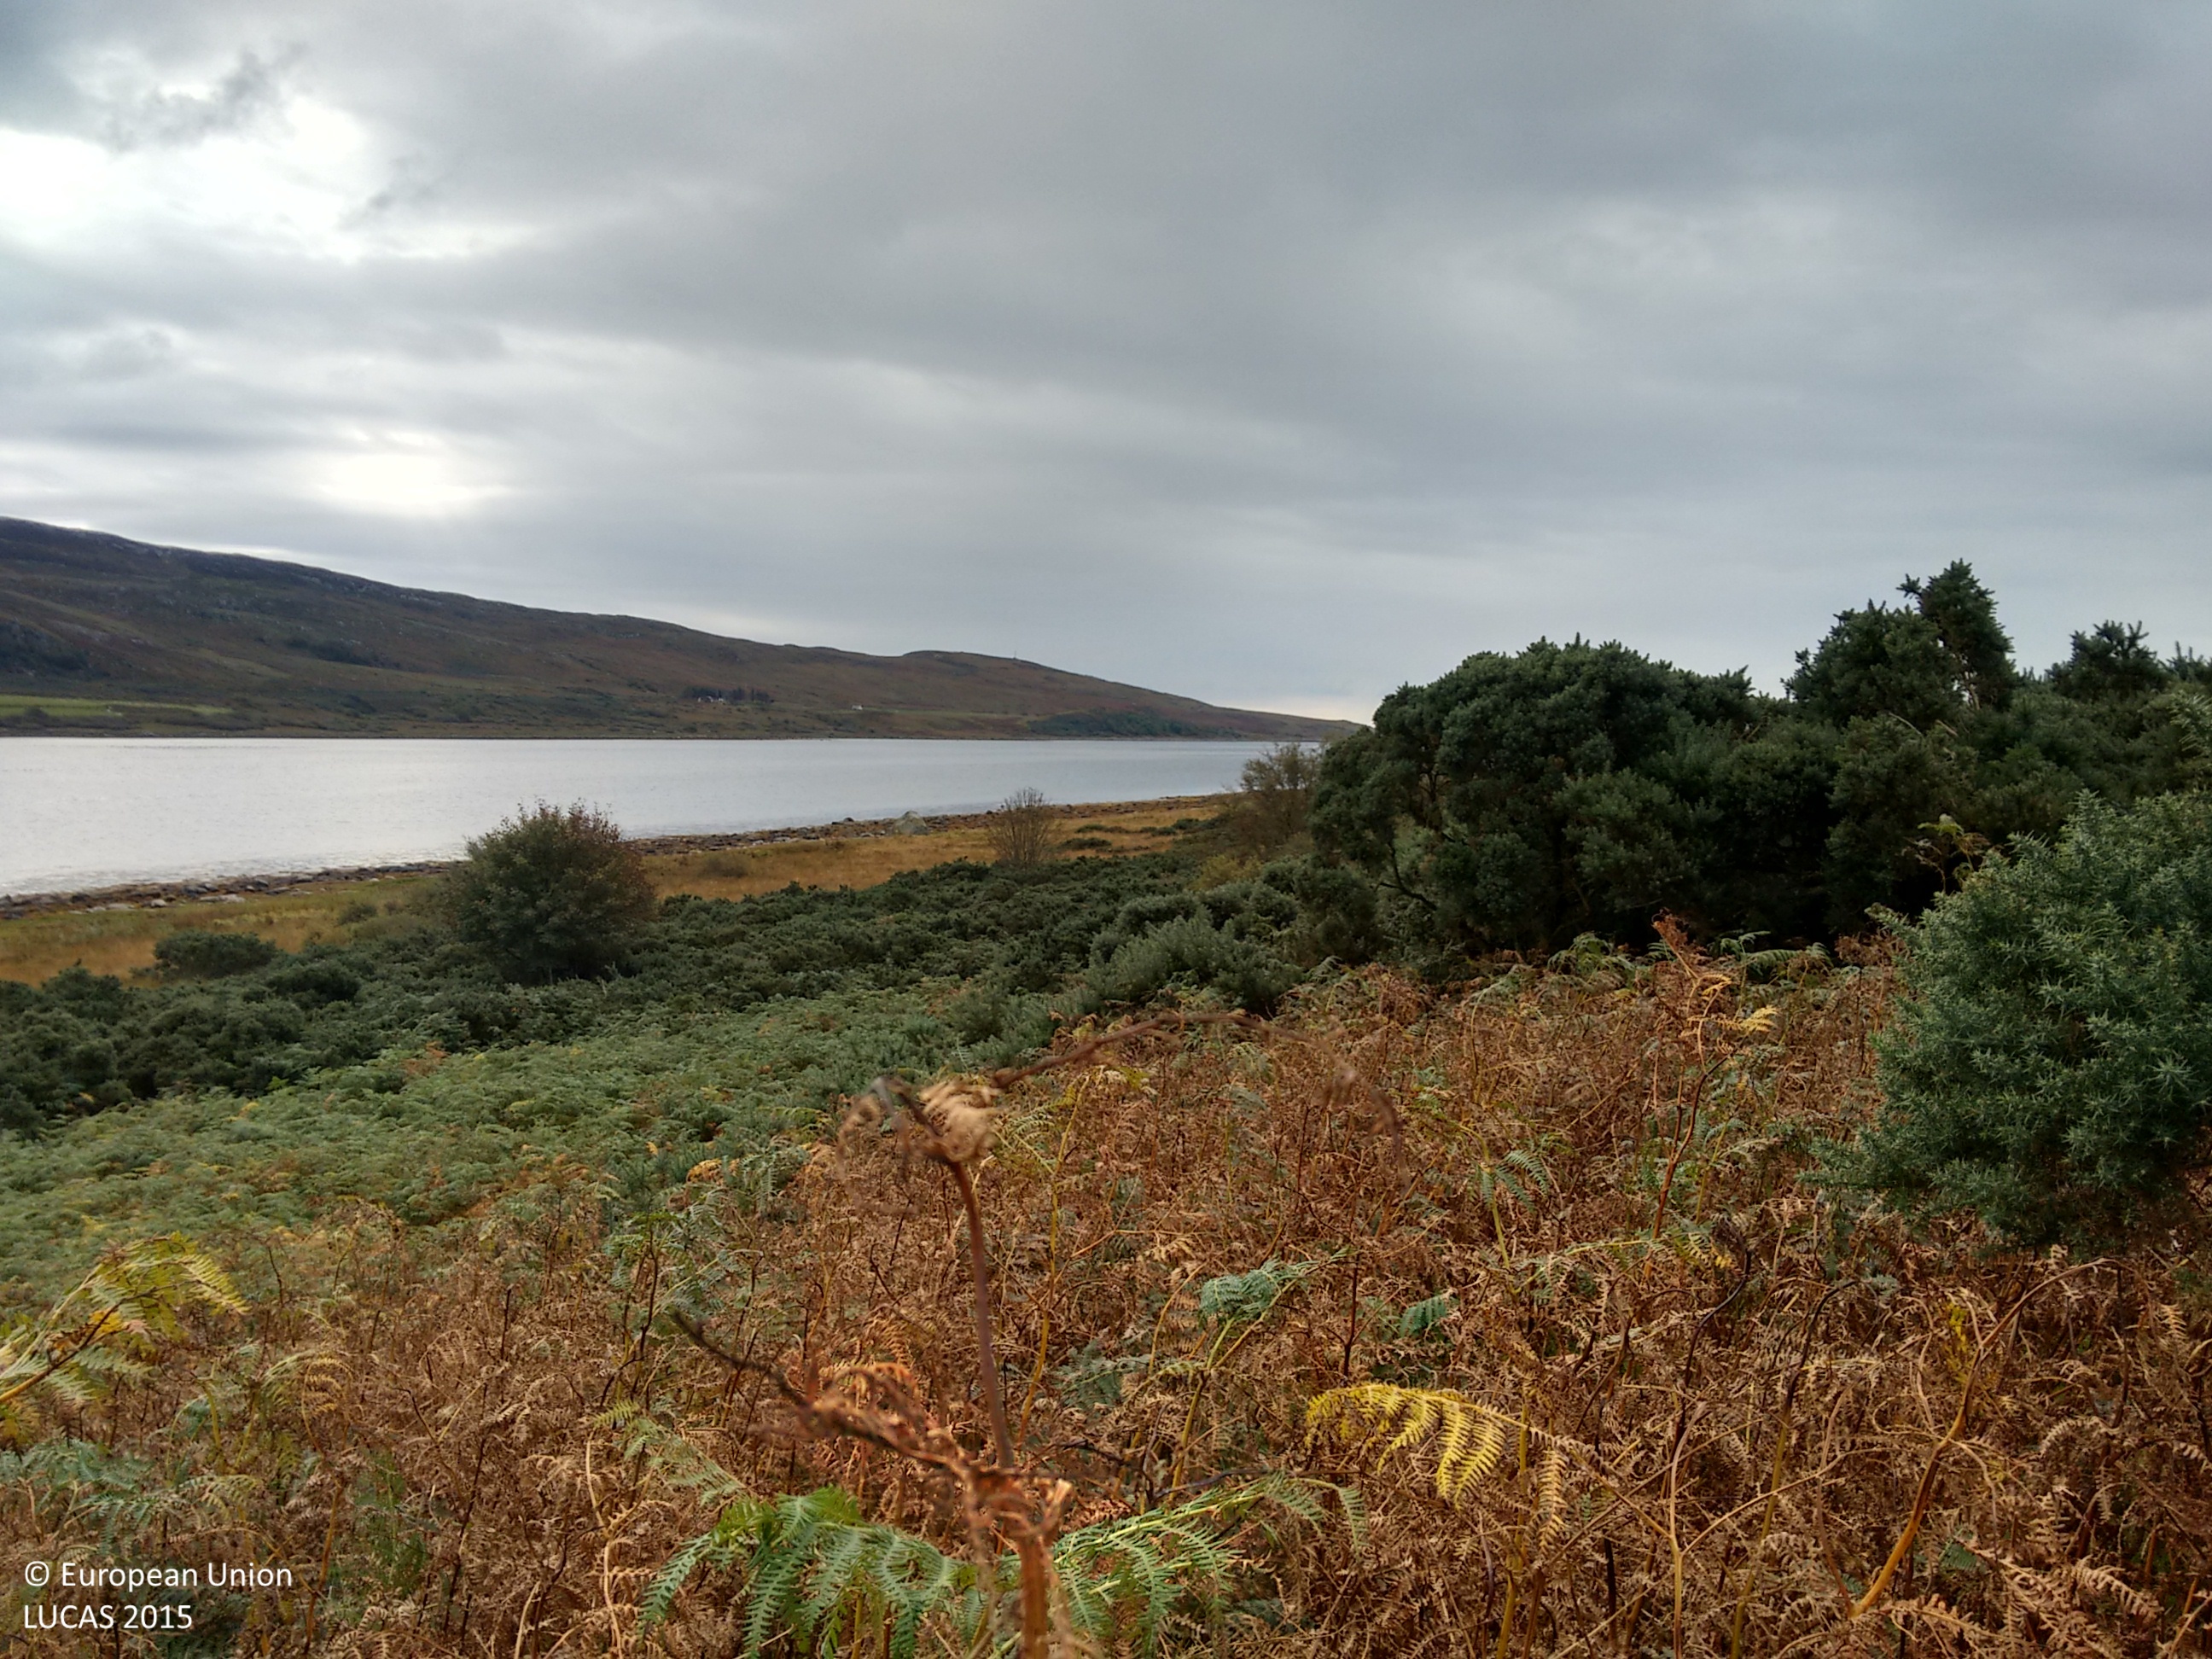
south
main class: Shrubland
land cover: Shrubland with sparse tree cover
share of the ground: > 75 %
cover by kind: shrubs 85 %, herbaceous plants 10 %, broadleaved forest trees 5 %
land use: Agriculture (excluding fallow land and kitchen gardens)
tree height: < 5 m
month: October
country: GB
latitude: 55.9496
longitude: -5.6767
